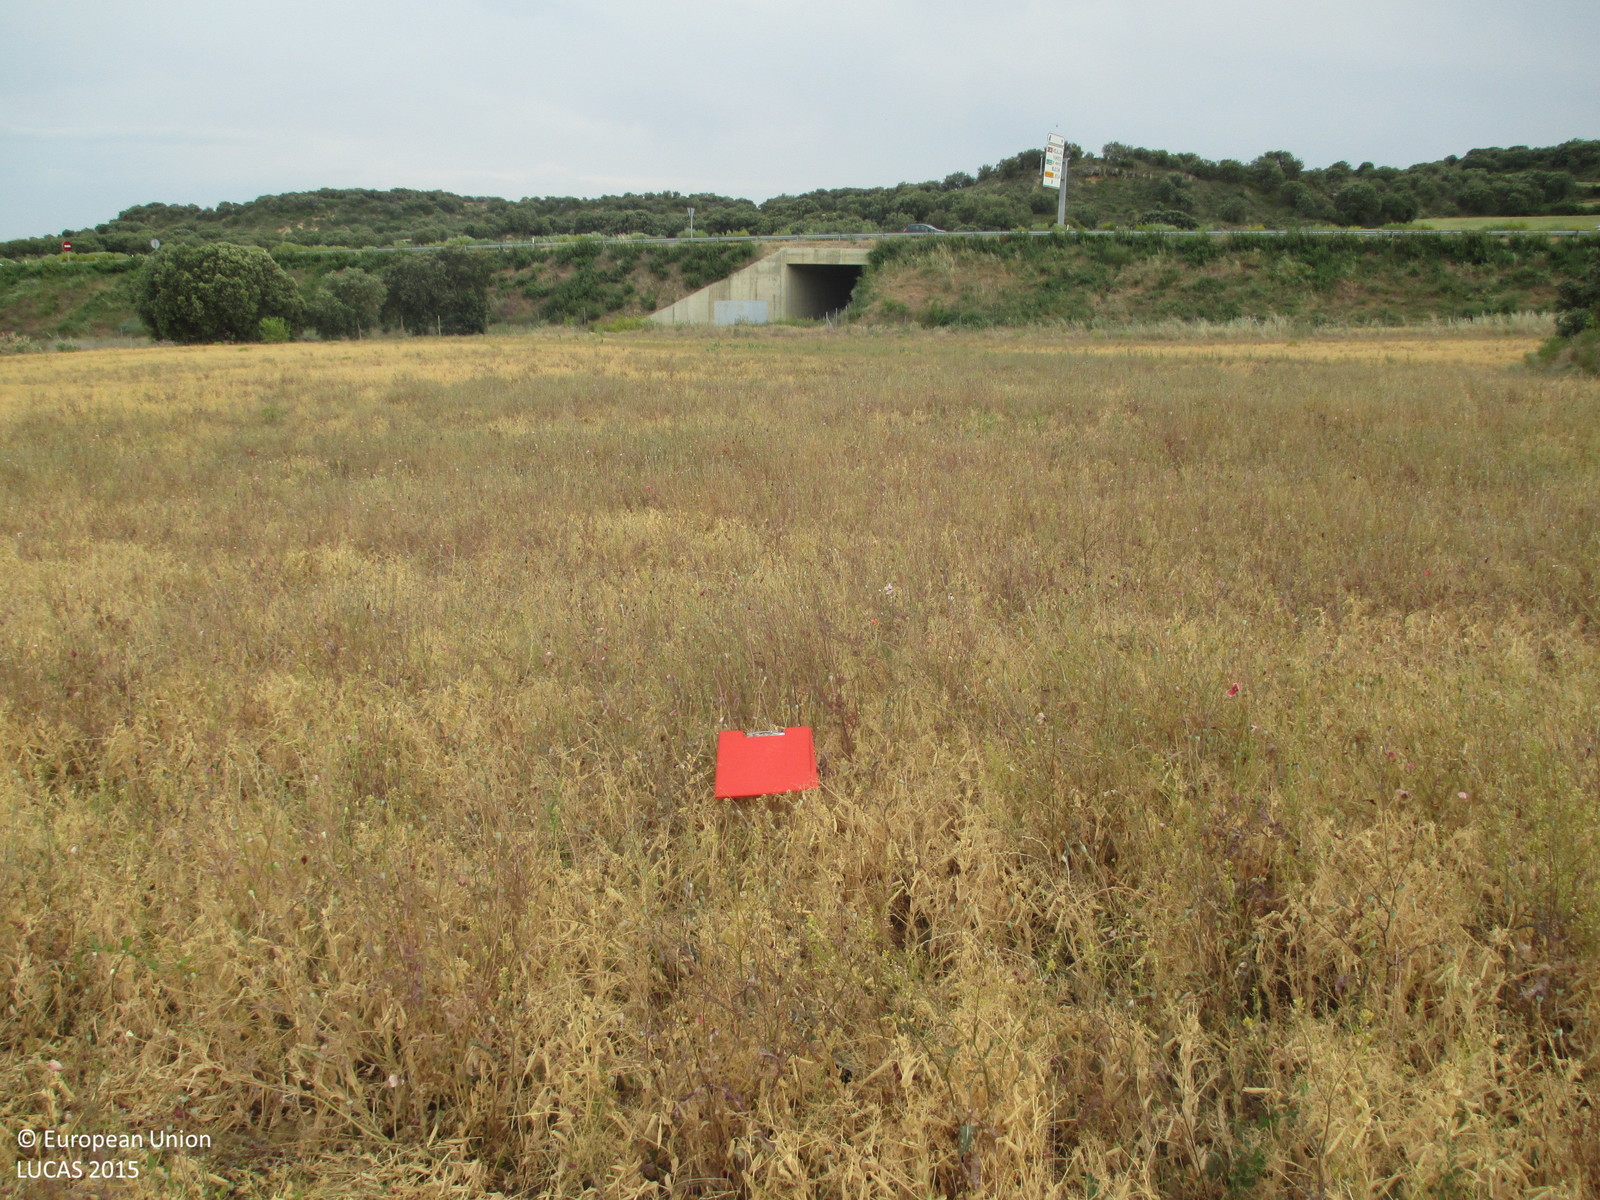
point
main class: Cropland
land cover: Dry pulses
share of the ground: > 75 %
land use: Agriculture (excluding fallow land and kitchen gardens)
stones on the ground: < 10 %
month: May
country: ES
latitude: 42.1154
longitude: -0.2412
